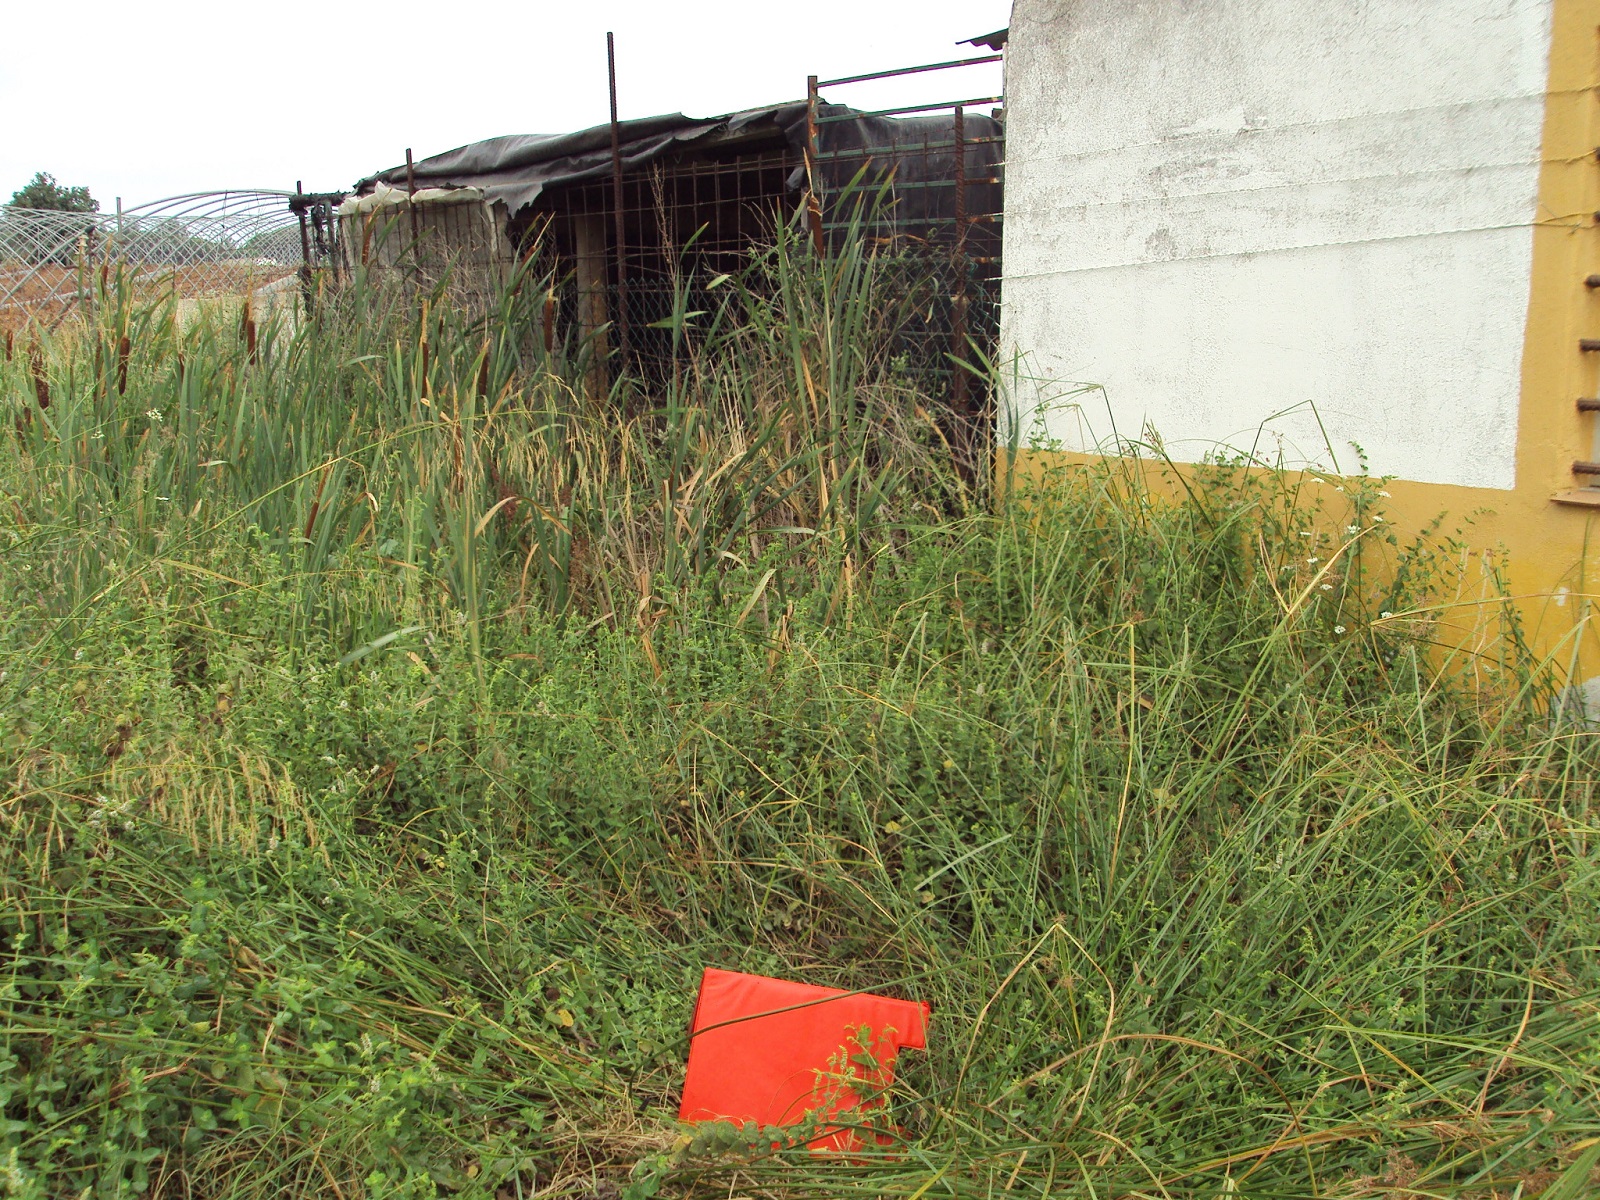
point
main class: Grassland
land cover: Spontaneously vegetated surfaces
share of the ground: > 75 %
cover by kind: herbaceous plants 100 %
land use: Semi-natural and natural areas not in use
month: June
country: ES
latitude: 37.2193
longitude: -6.9070
